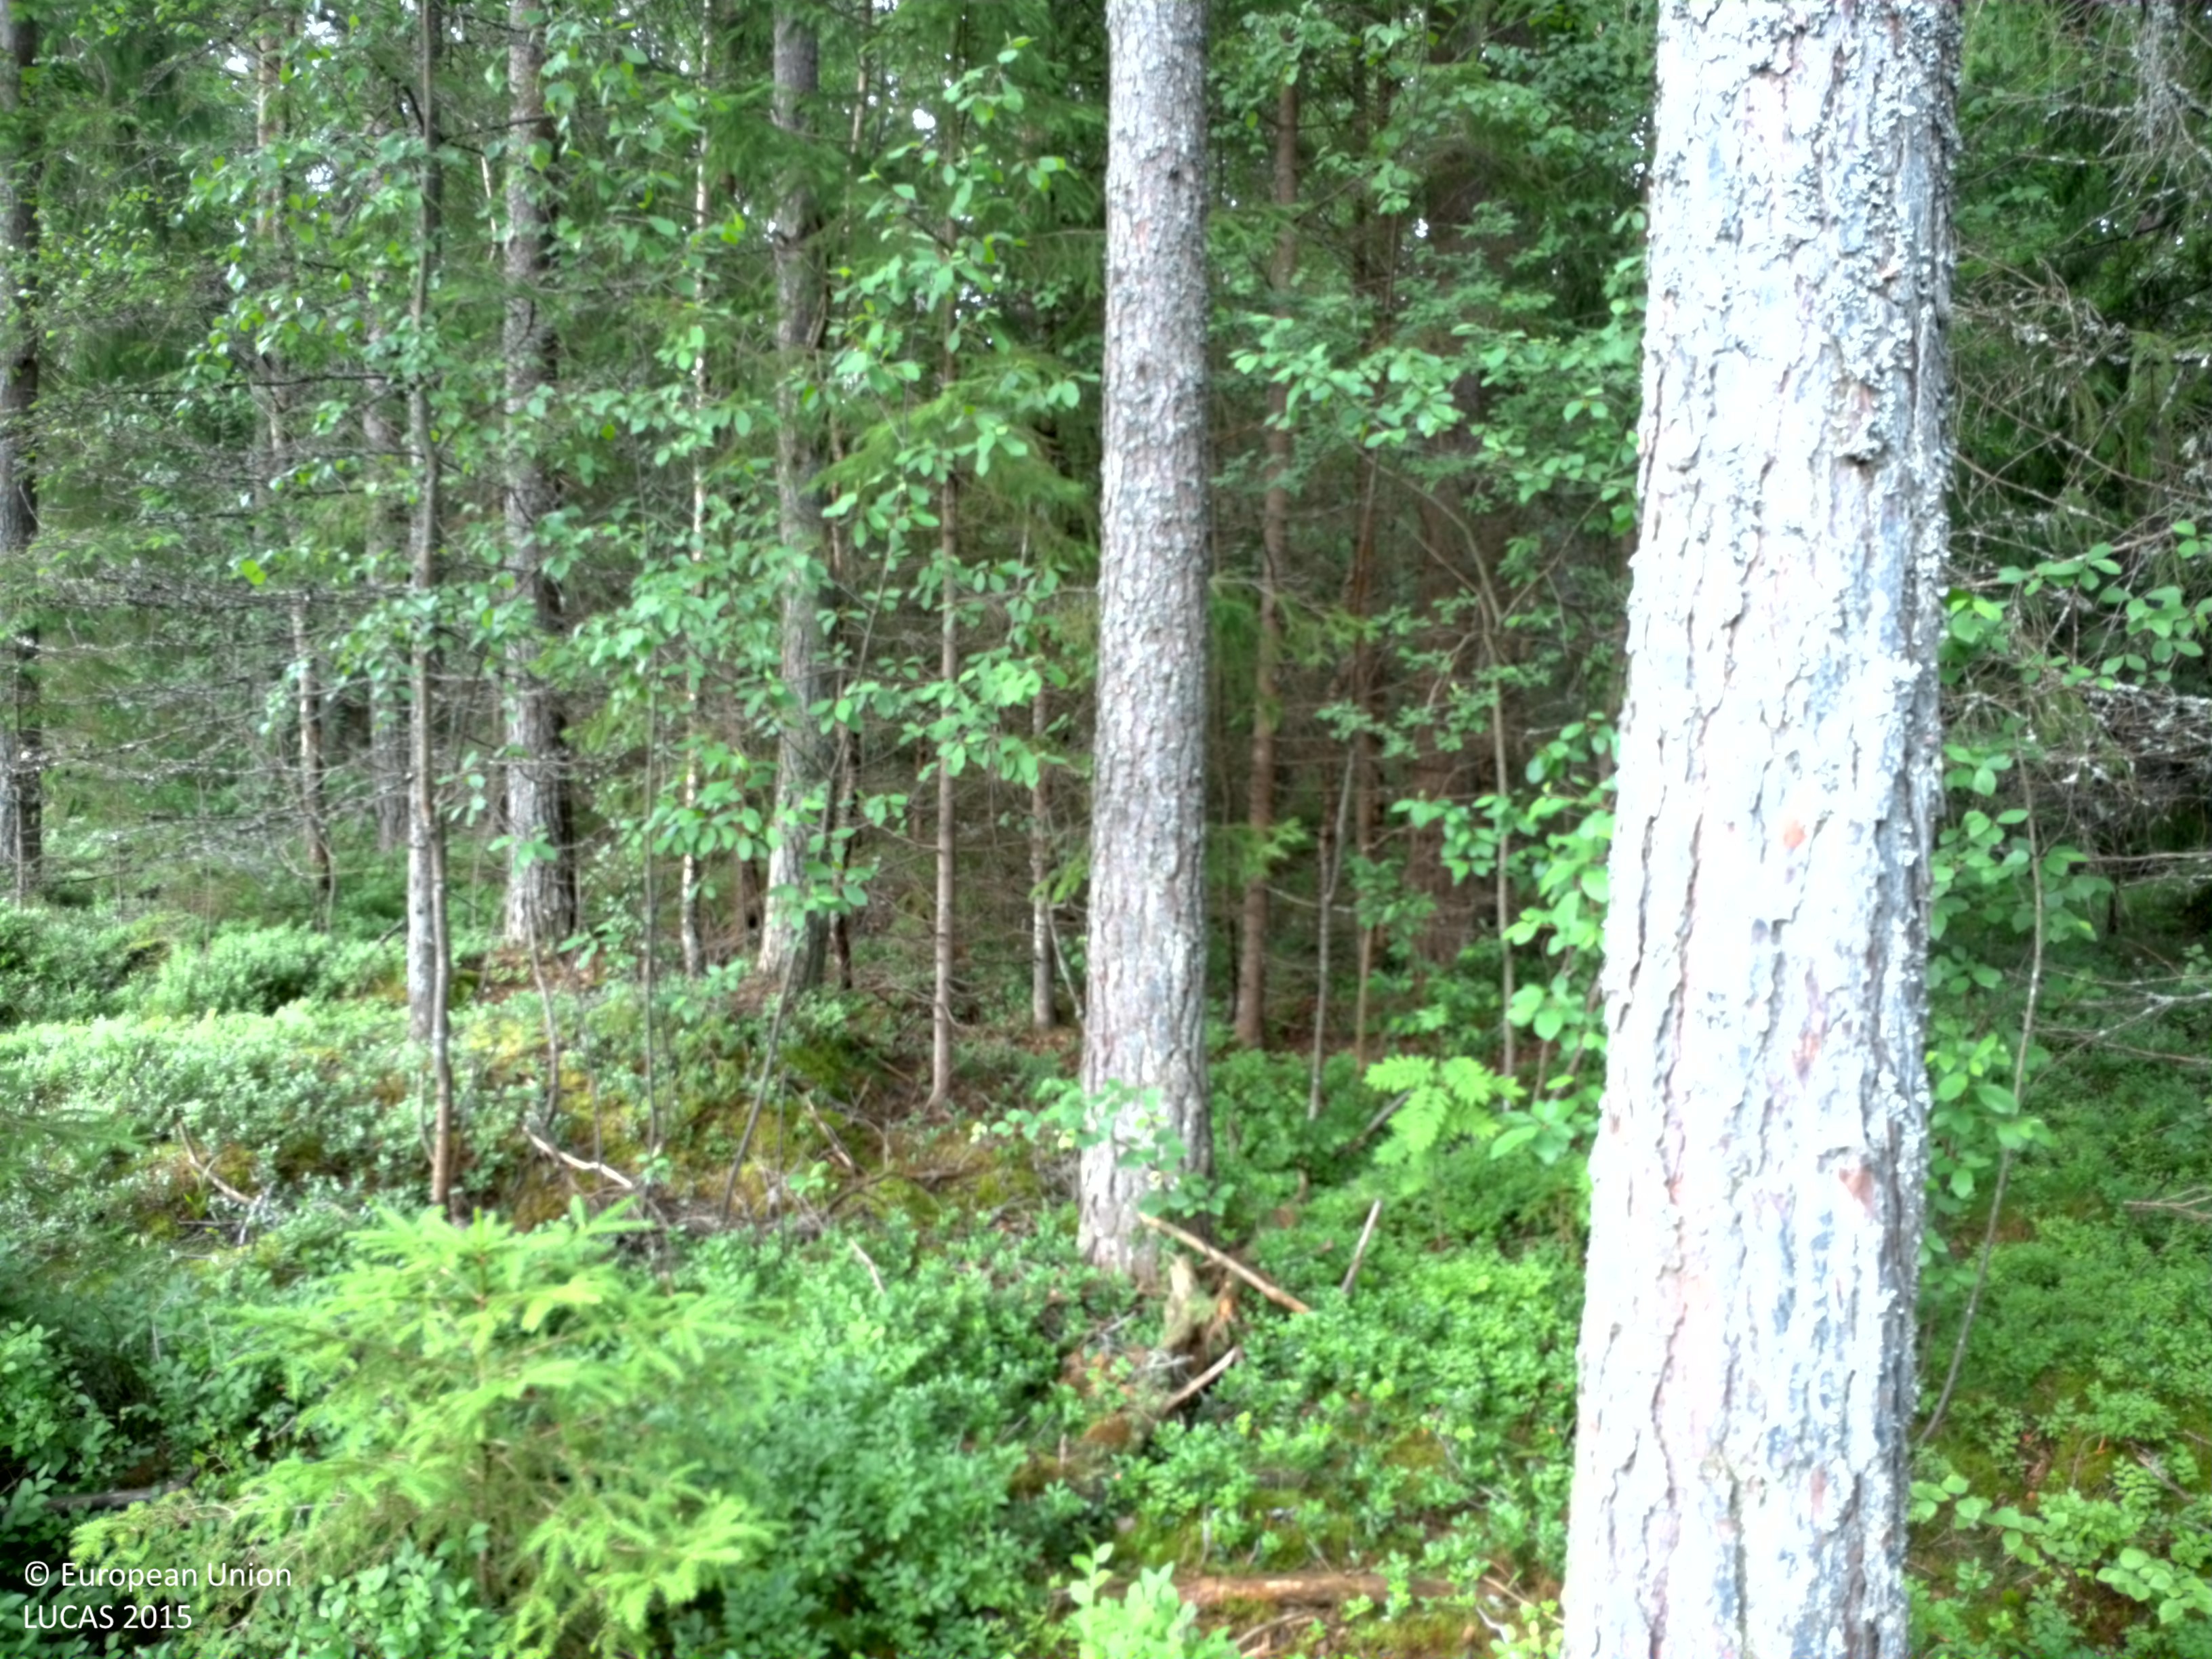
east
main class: Woodland
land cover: Other mixed woodland
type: boreal forest
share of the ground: 50 - 75 %
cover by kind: coniferous forest trees 40 %, shrubs 30 %, broadleaved forest trees 25 %, lichens and mosses 5 %
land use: Forestry
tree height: > 5 m
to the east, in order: Other mixed woodland; Pine dominated mixed woodland; Spruce dominated mixed woodland; Grass margins; Paved roads, cycling and walking lanes; Grass margins; Fences; Broadleaved woodland; Fences; Spruce dominated mixed woodland; Dry stone walls; Spruce dominated mixed woodland; Ditches and canals; Other leguminous and mixtures for fodder
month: July
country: SE
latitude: 58.7411
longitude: 14.4333
